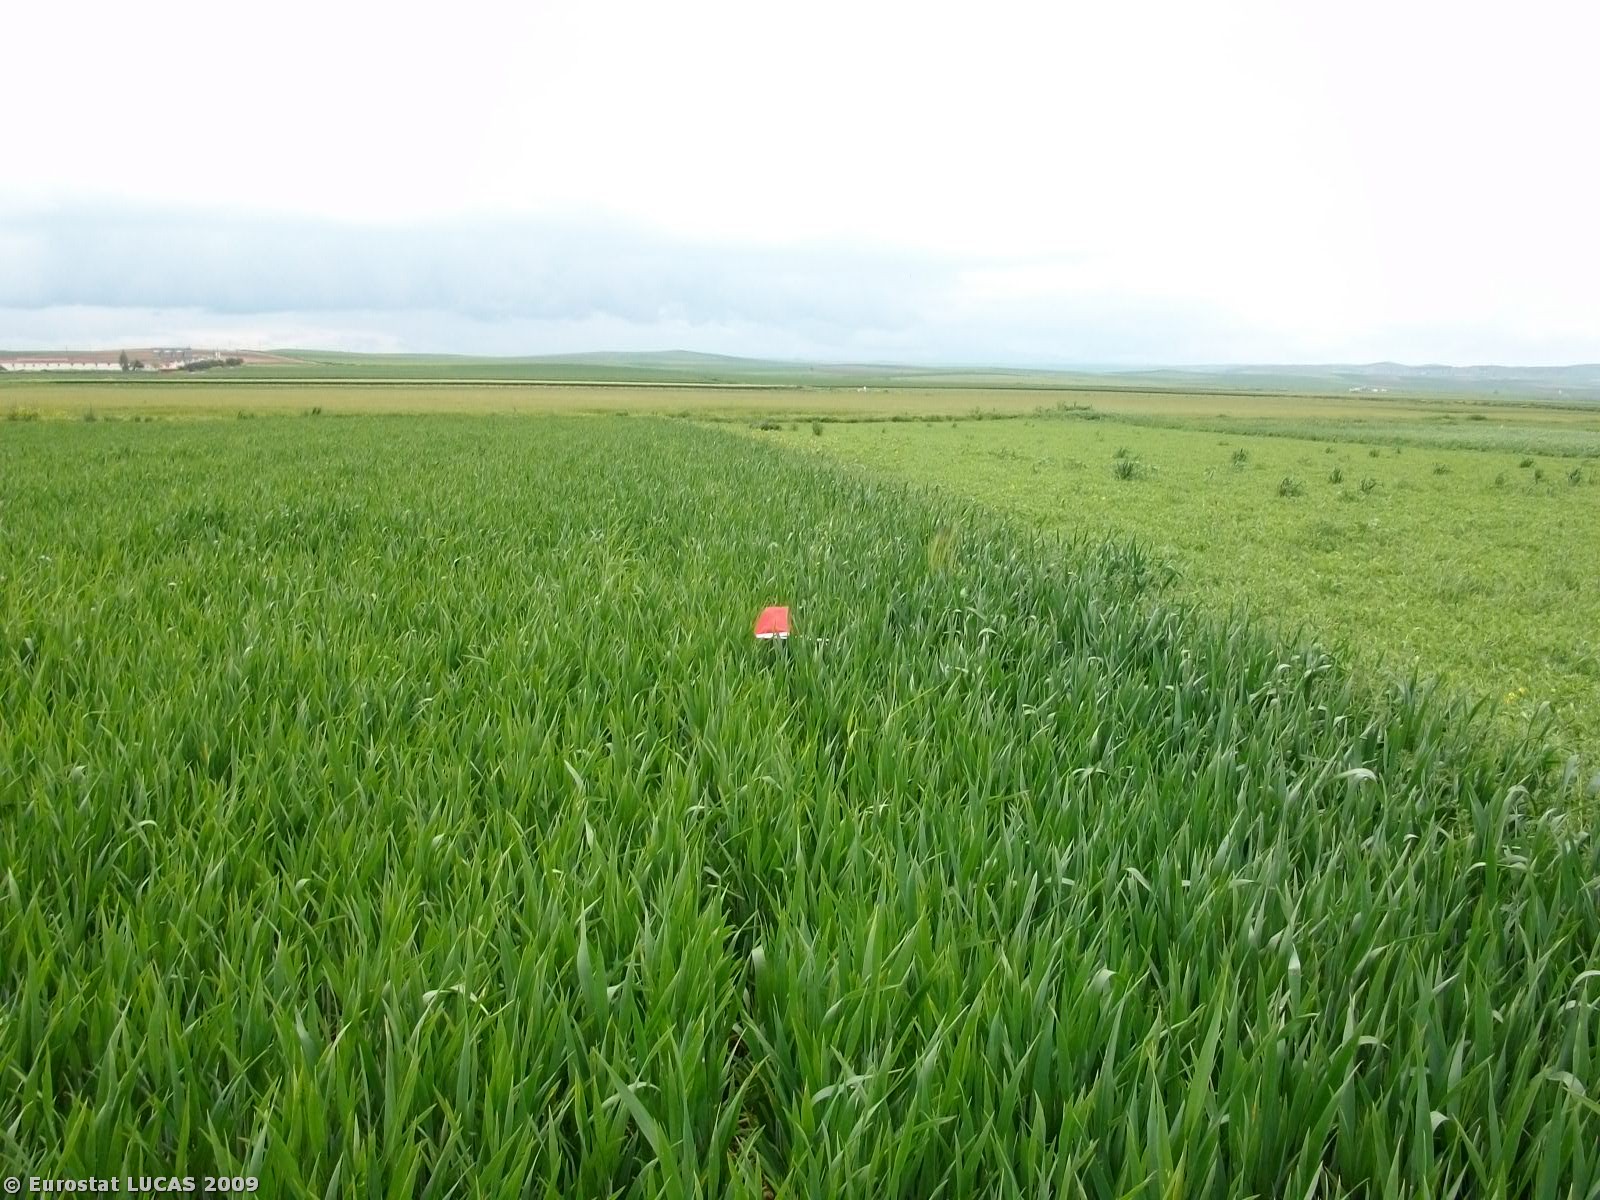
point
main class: Cropland
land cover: Durum wheat
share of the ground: > 75 %
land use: Agriculture (excluding fallow land and kitchen gardens)
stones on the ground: < 10 %
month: April
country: GR
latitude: 39.5171
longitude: 22.3758
